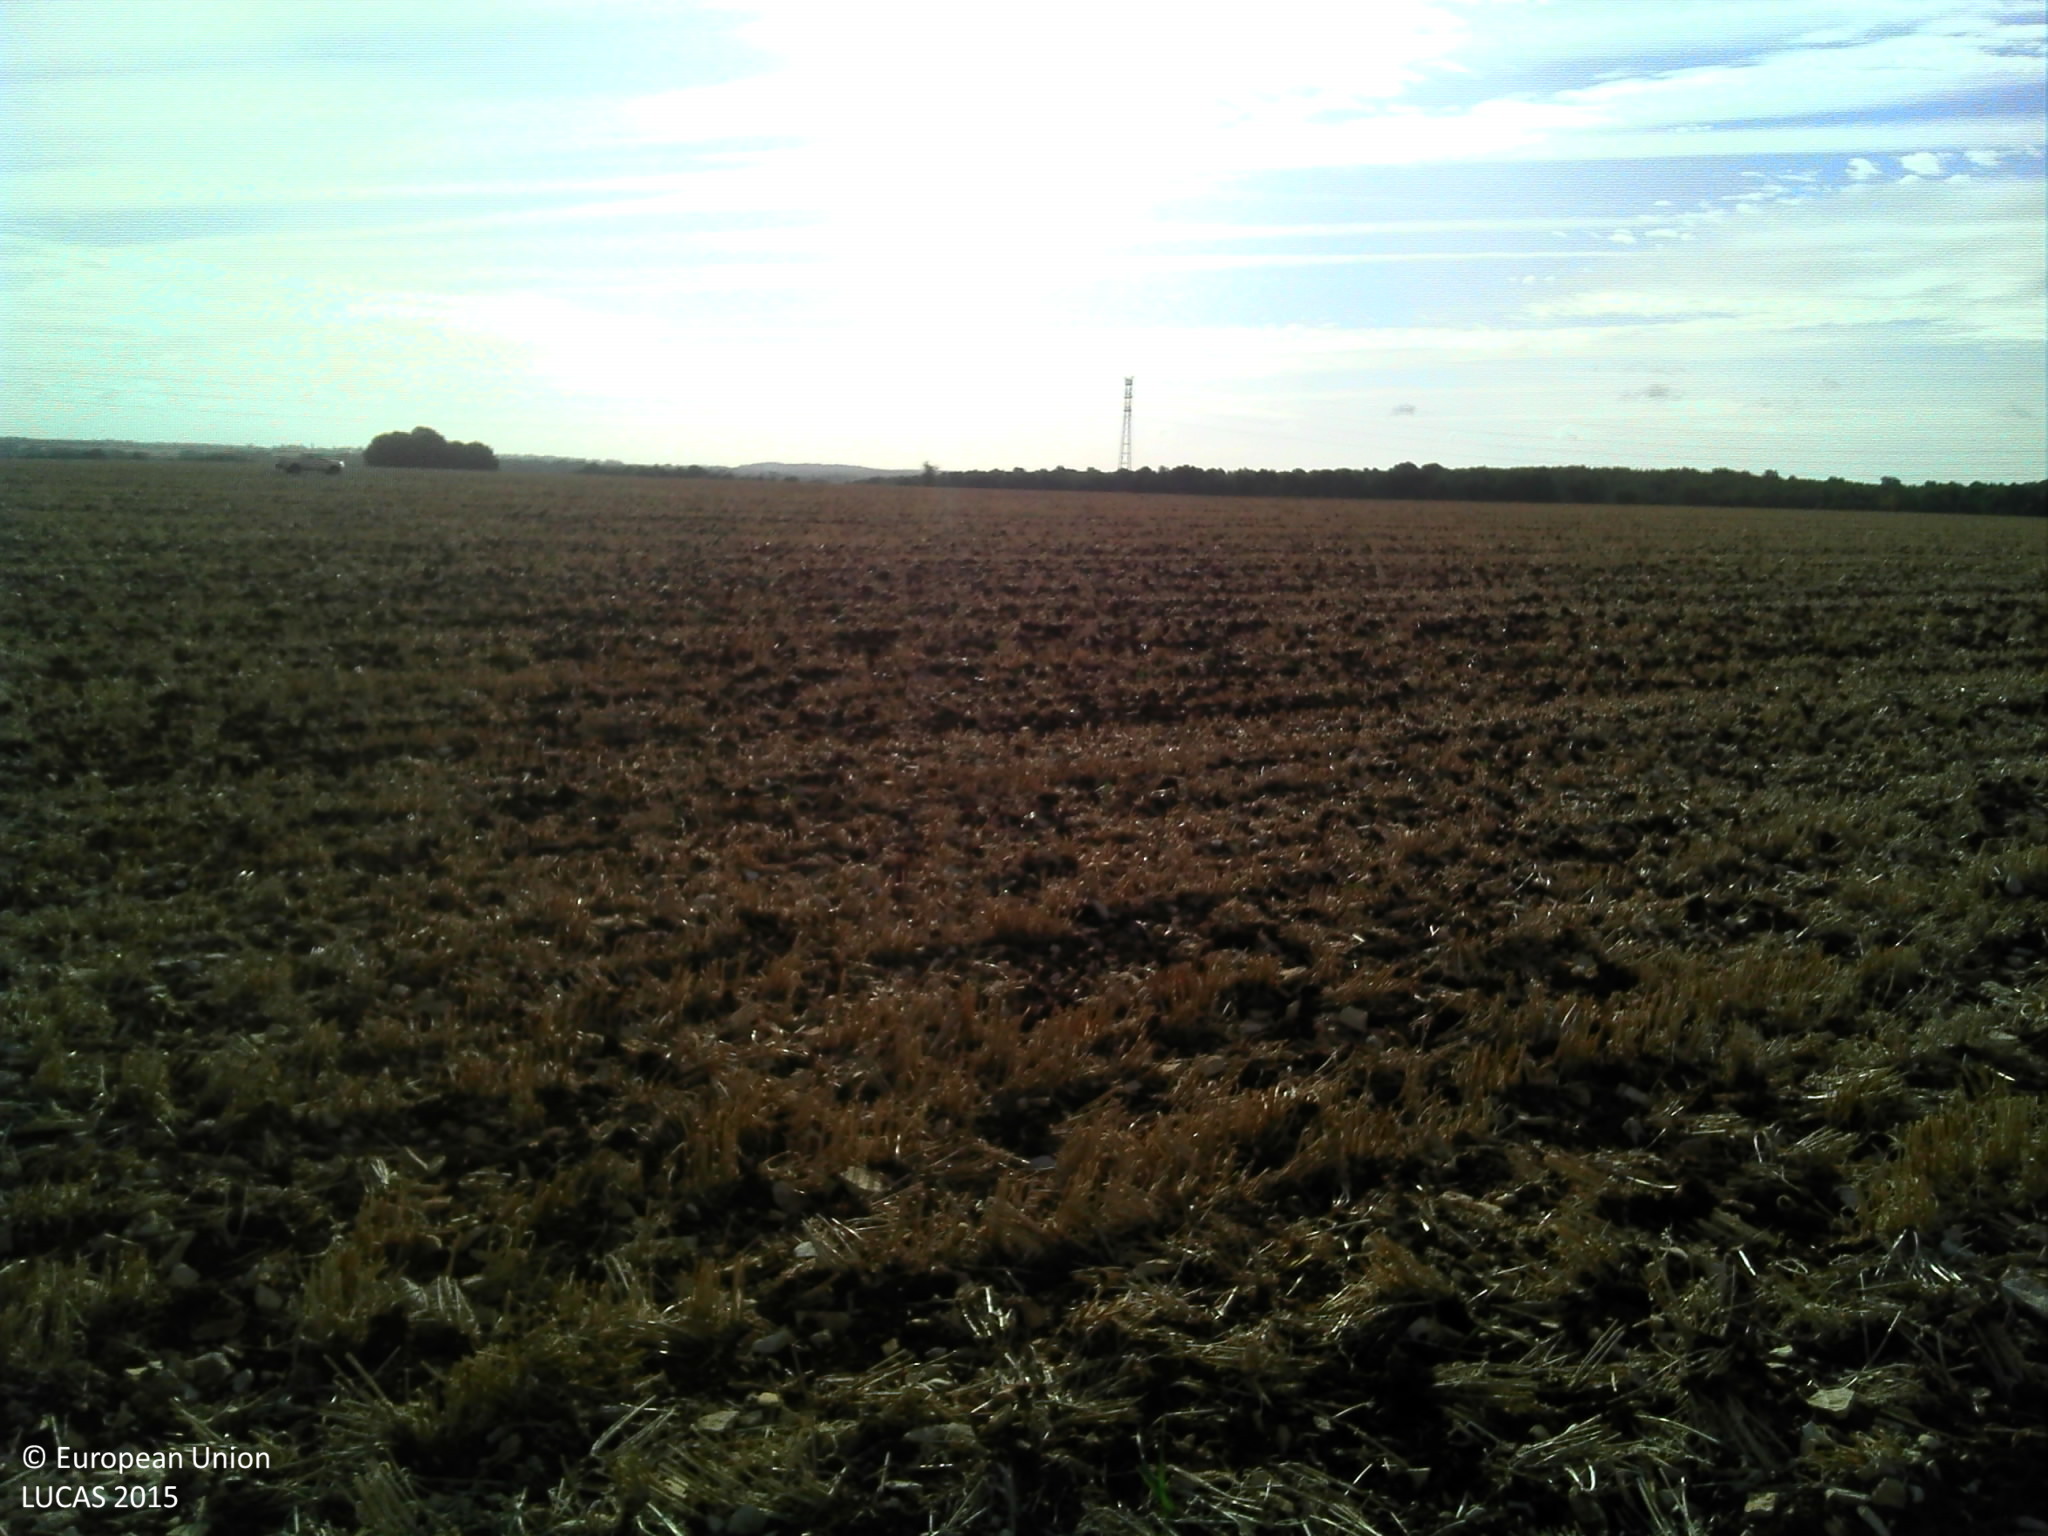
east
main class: Cropland
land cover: Barley
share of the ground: > 75 %
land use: Agriculture (excluding fallow land and kitchen gardens)
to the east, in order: Barley; Grass margins; Tracks; Grass margins; Common wheat
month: July
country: FR
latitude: 46.9205
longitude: 2.2579
